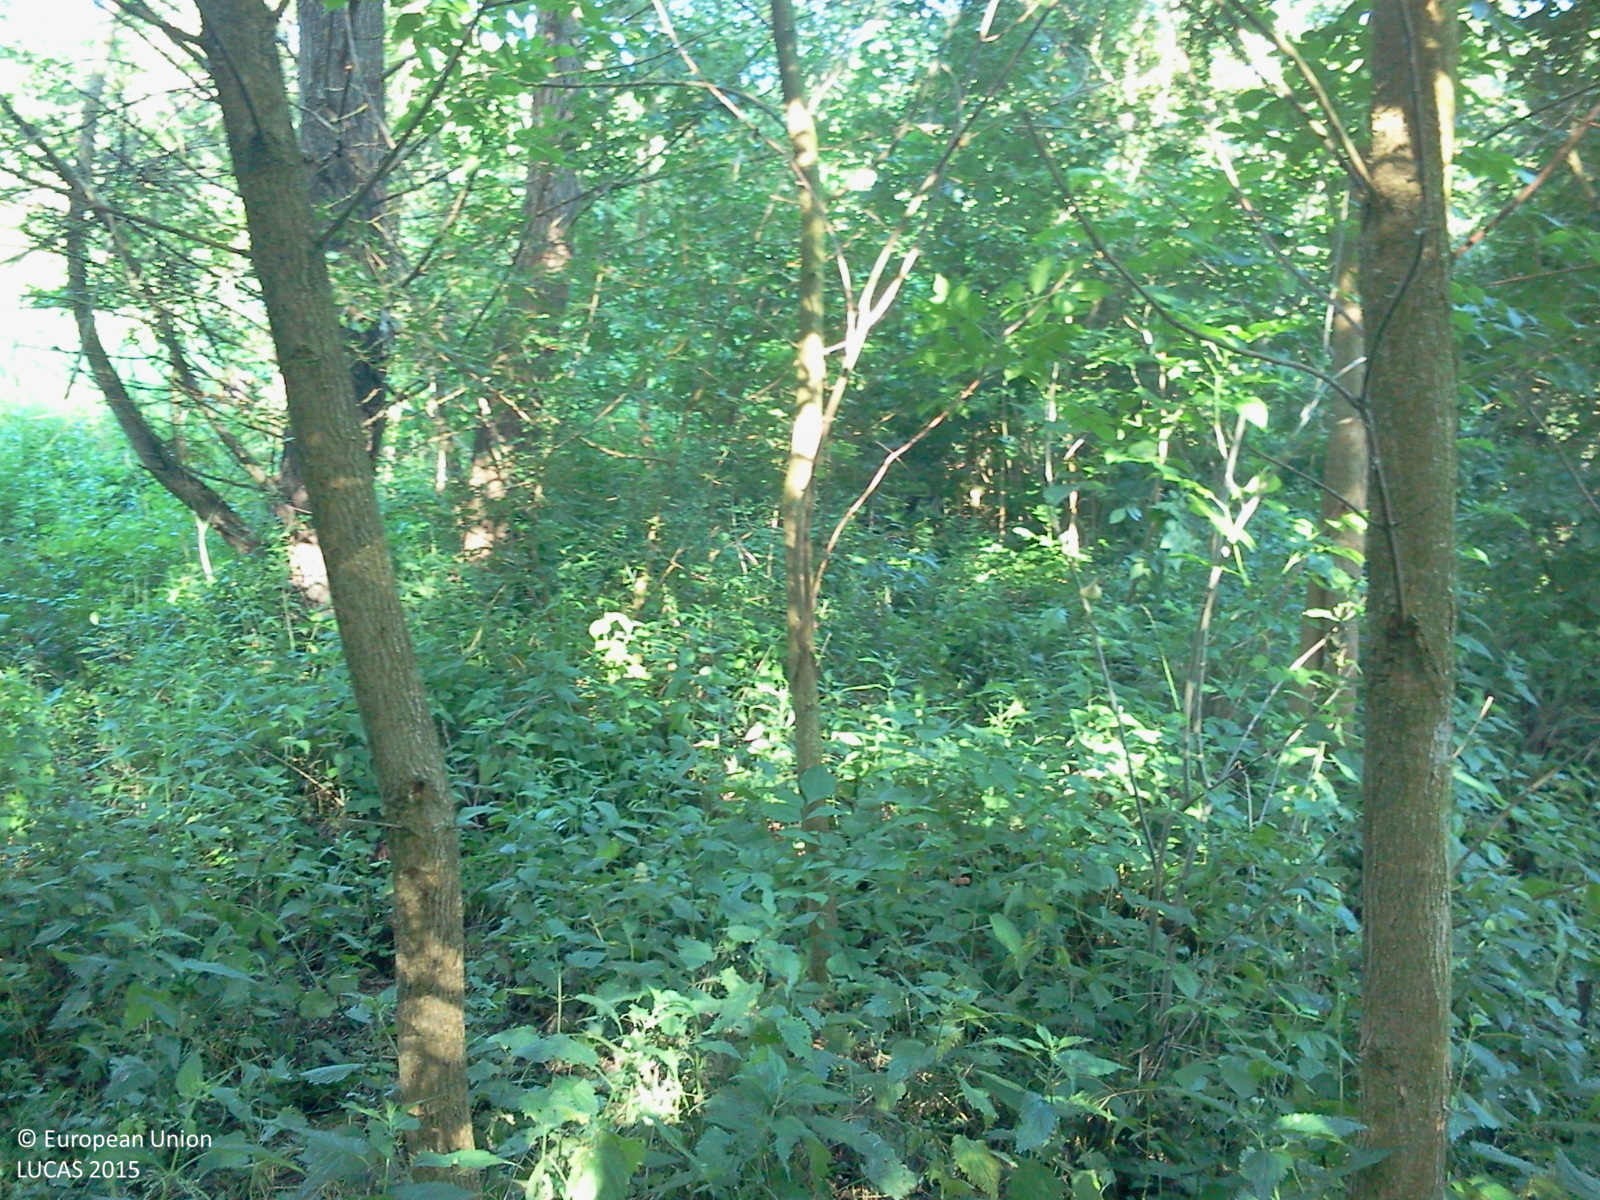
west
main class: Woodland
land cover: Broadleaved woodland
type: thermophilous deciduous forest
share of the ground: > 75 %
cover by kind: broadleaved forest trees 65 %, shrubs 20 %, herbaceous plants 15 %
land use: Forestry
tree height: > 5 m
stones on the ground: < 10 %
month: June
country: HU
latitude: 46.6950
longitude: 17.0784
